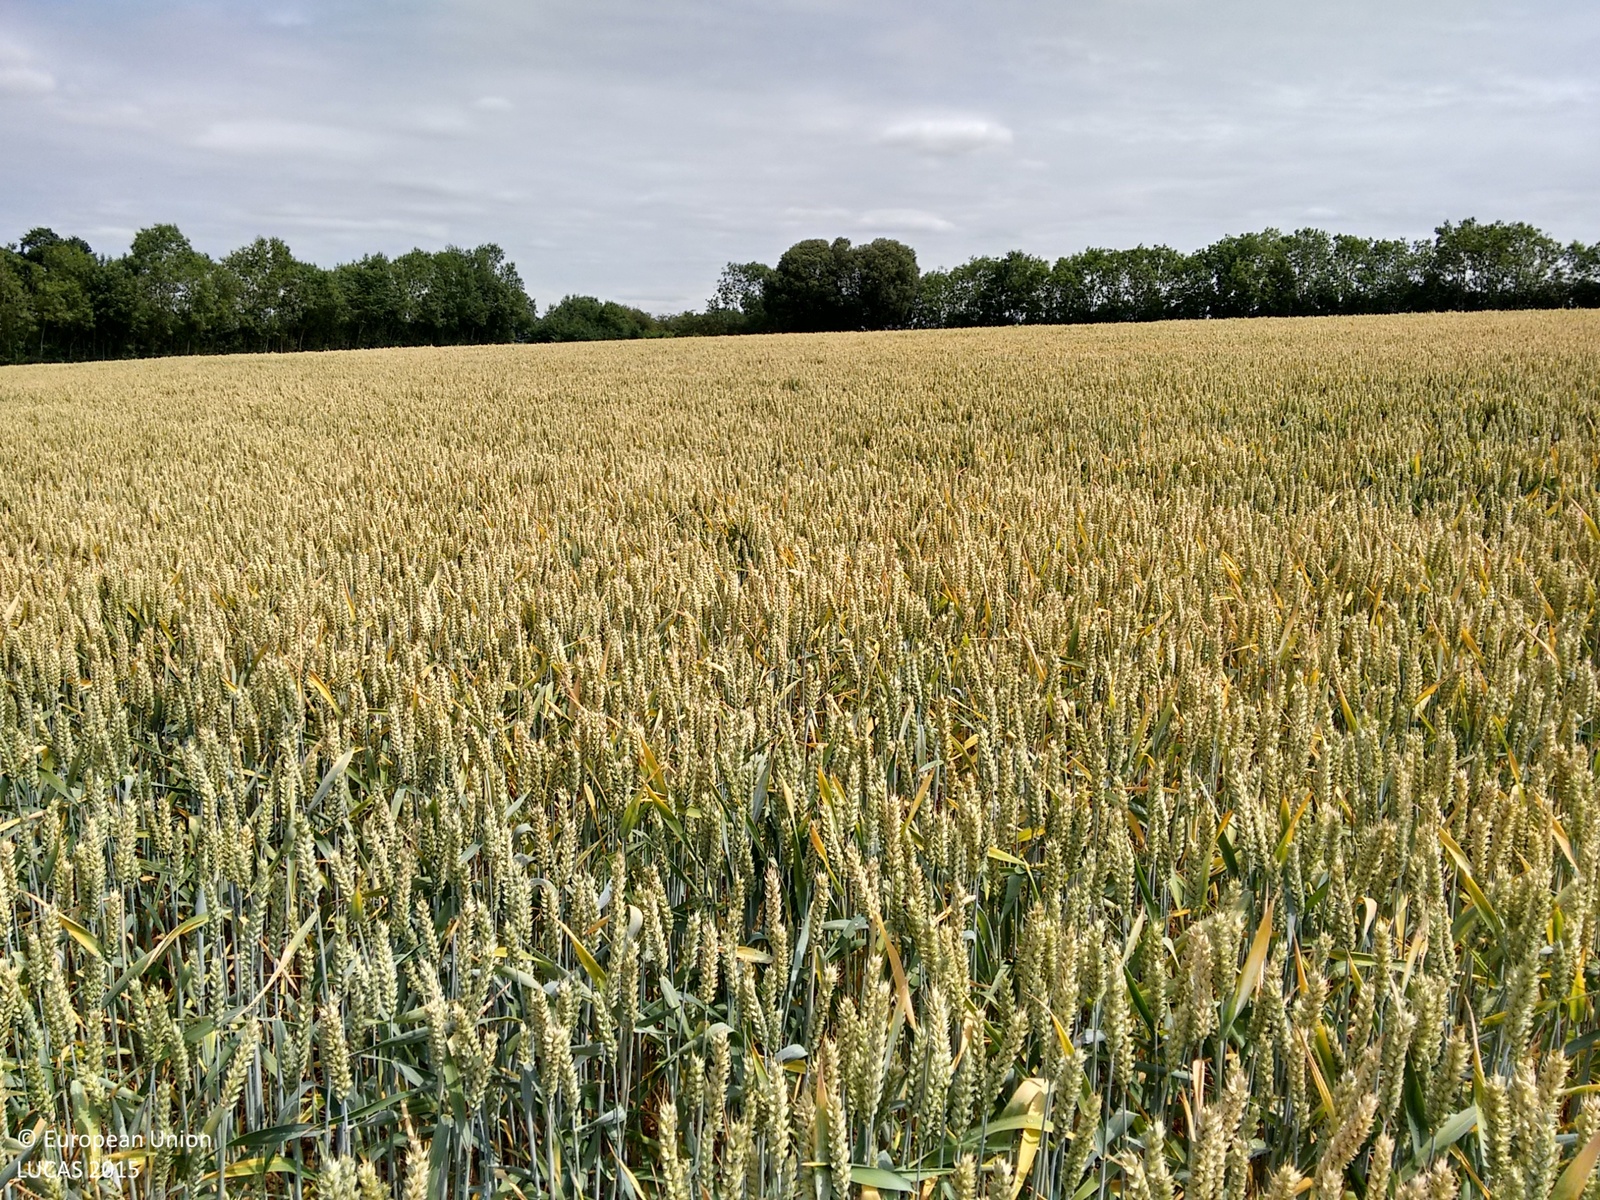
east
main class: Cropland
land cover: Common wheat
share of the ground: > 75 %
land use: Agriculture (excluding fallow land and kitchen gardens)
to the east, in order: Common wheat; Grass margins; Tracks; Broadleaved woodland; Maize; Common wheat
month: July
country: GB
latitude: 52.6320
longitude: -0.5436
